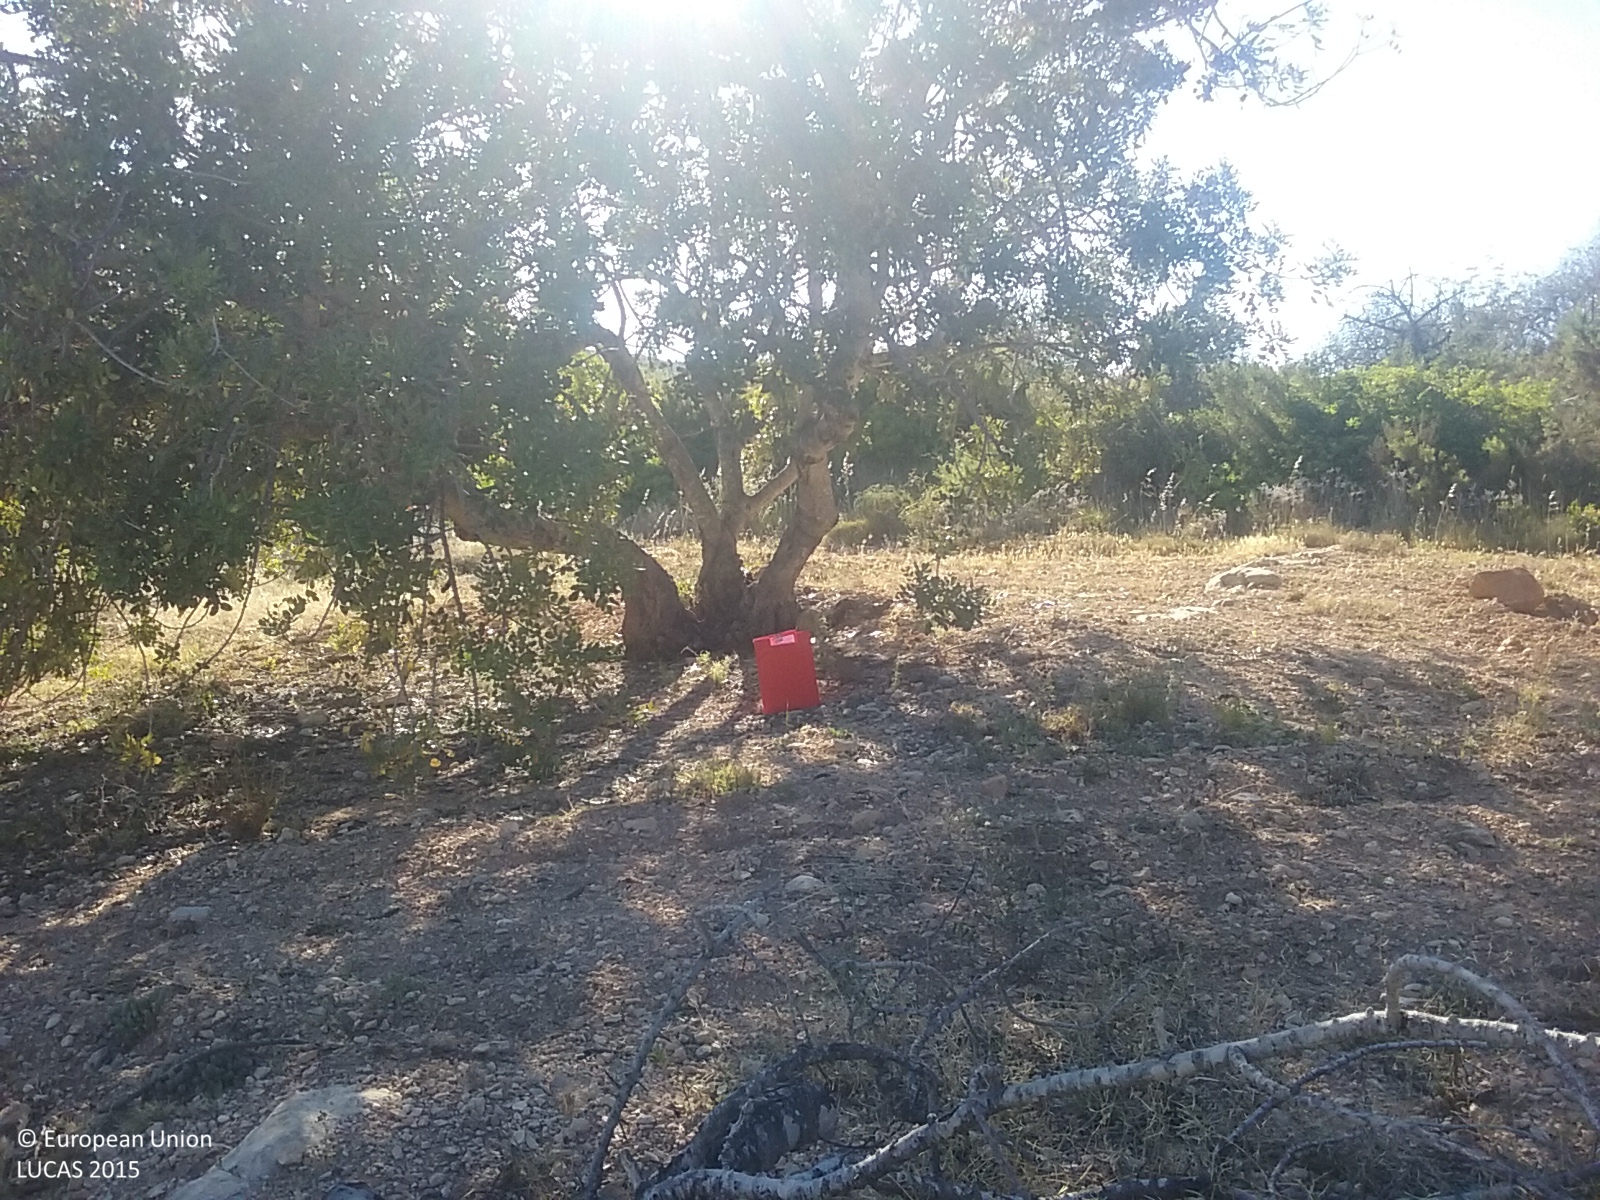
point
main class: Cropland
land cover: Permanent industrial crops
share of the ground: 10 - 25 %
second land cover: Other bare soil
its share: > 75 %
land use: Agriculture (excluding fallow land and kitchen gardens)
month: May
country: ES
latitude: 40.3439
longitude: 0.2374
